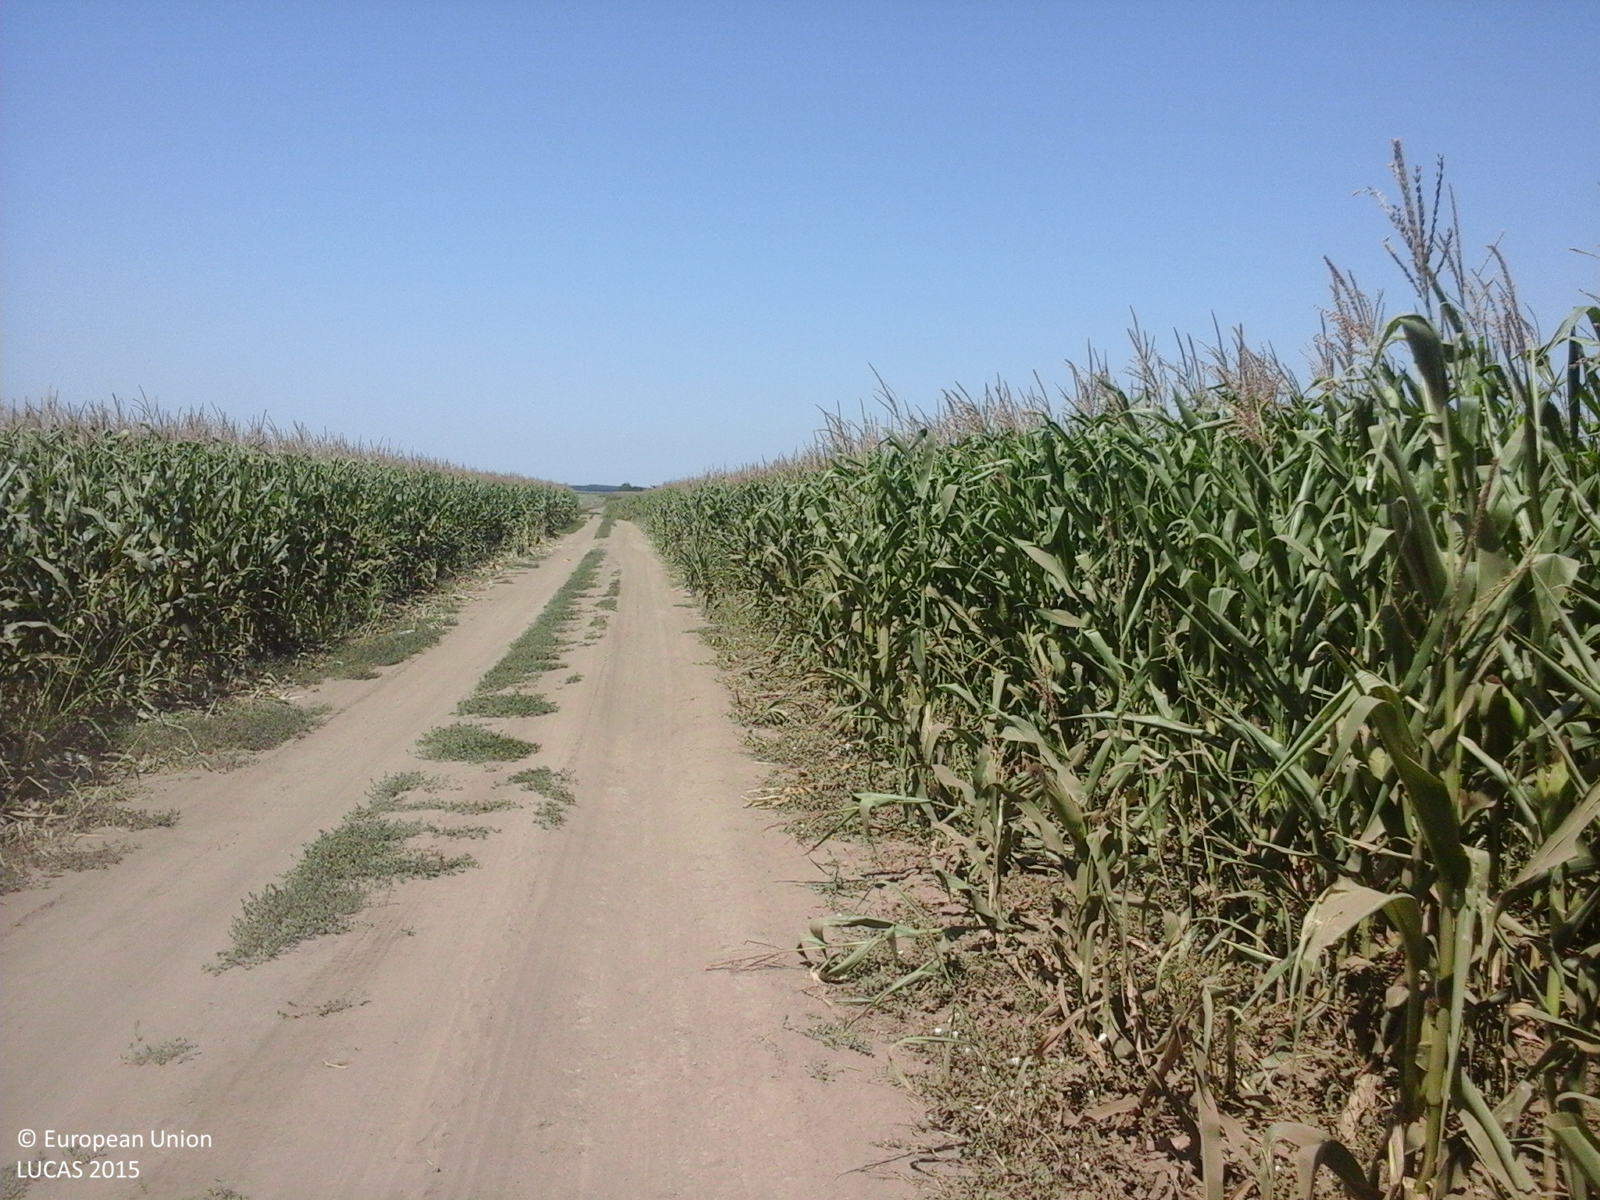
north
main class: Cropland
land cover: Maize
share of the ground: > 75 %
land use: Agriculture (excluding fallow land and kitchen gardens)
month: July
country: RO
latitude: 44.1510
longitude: 26.6569
